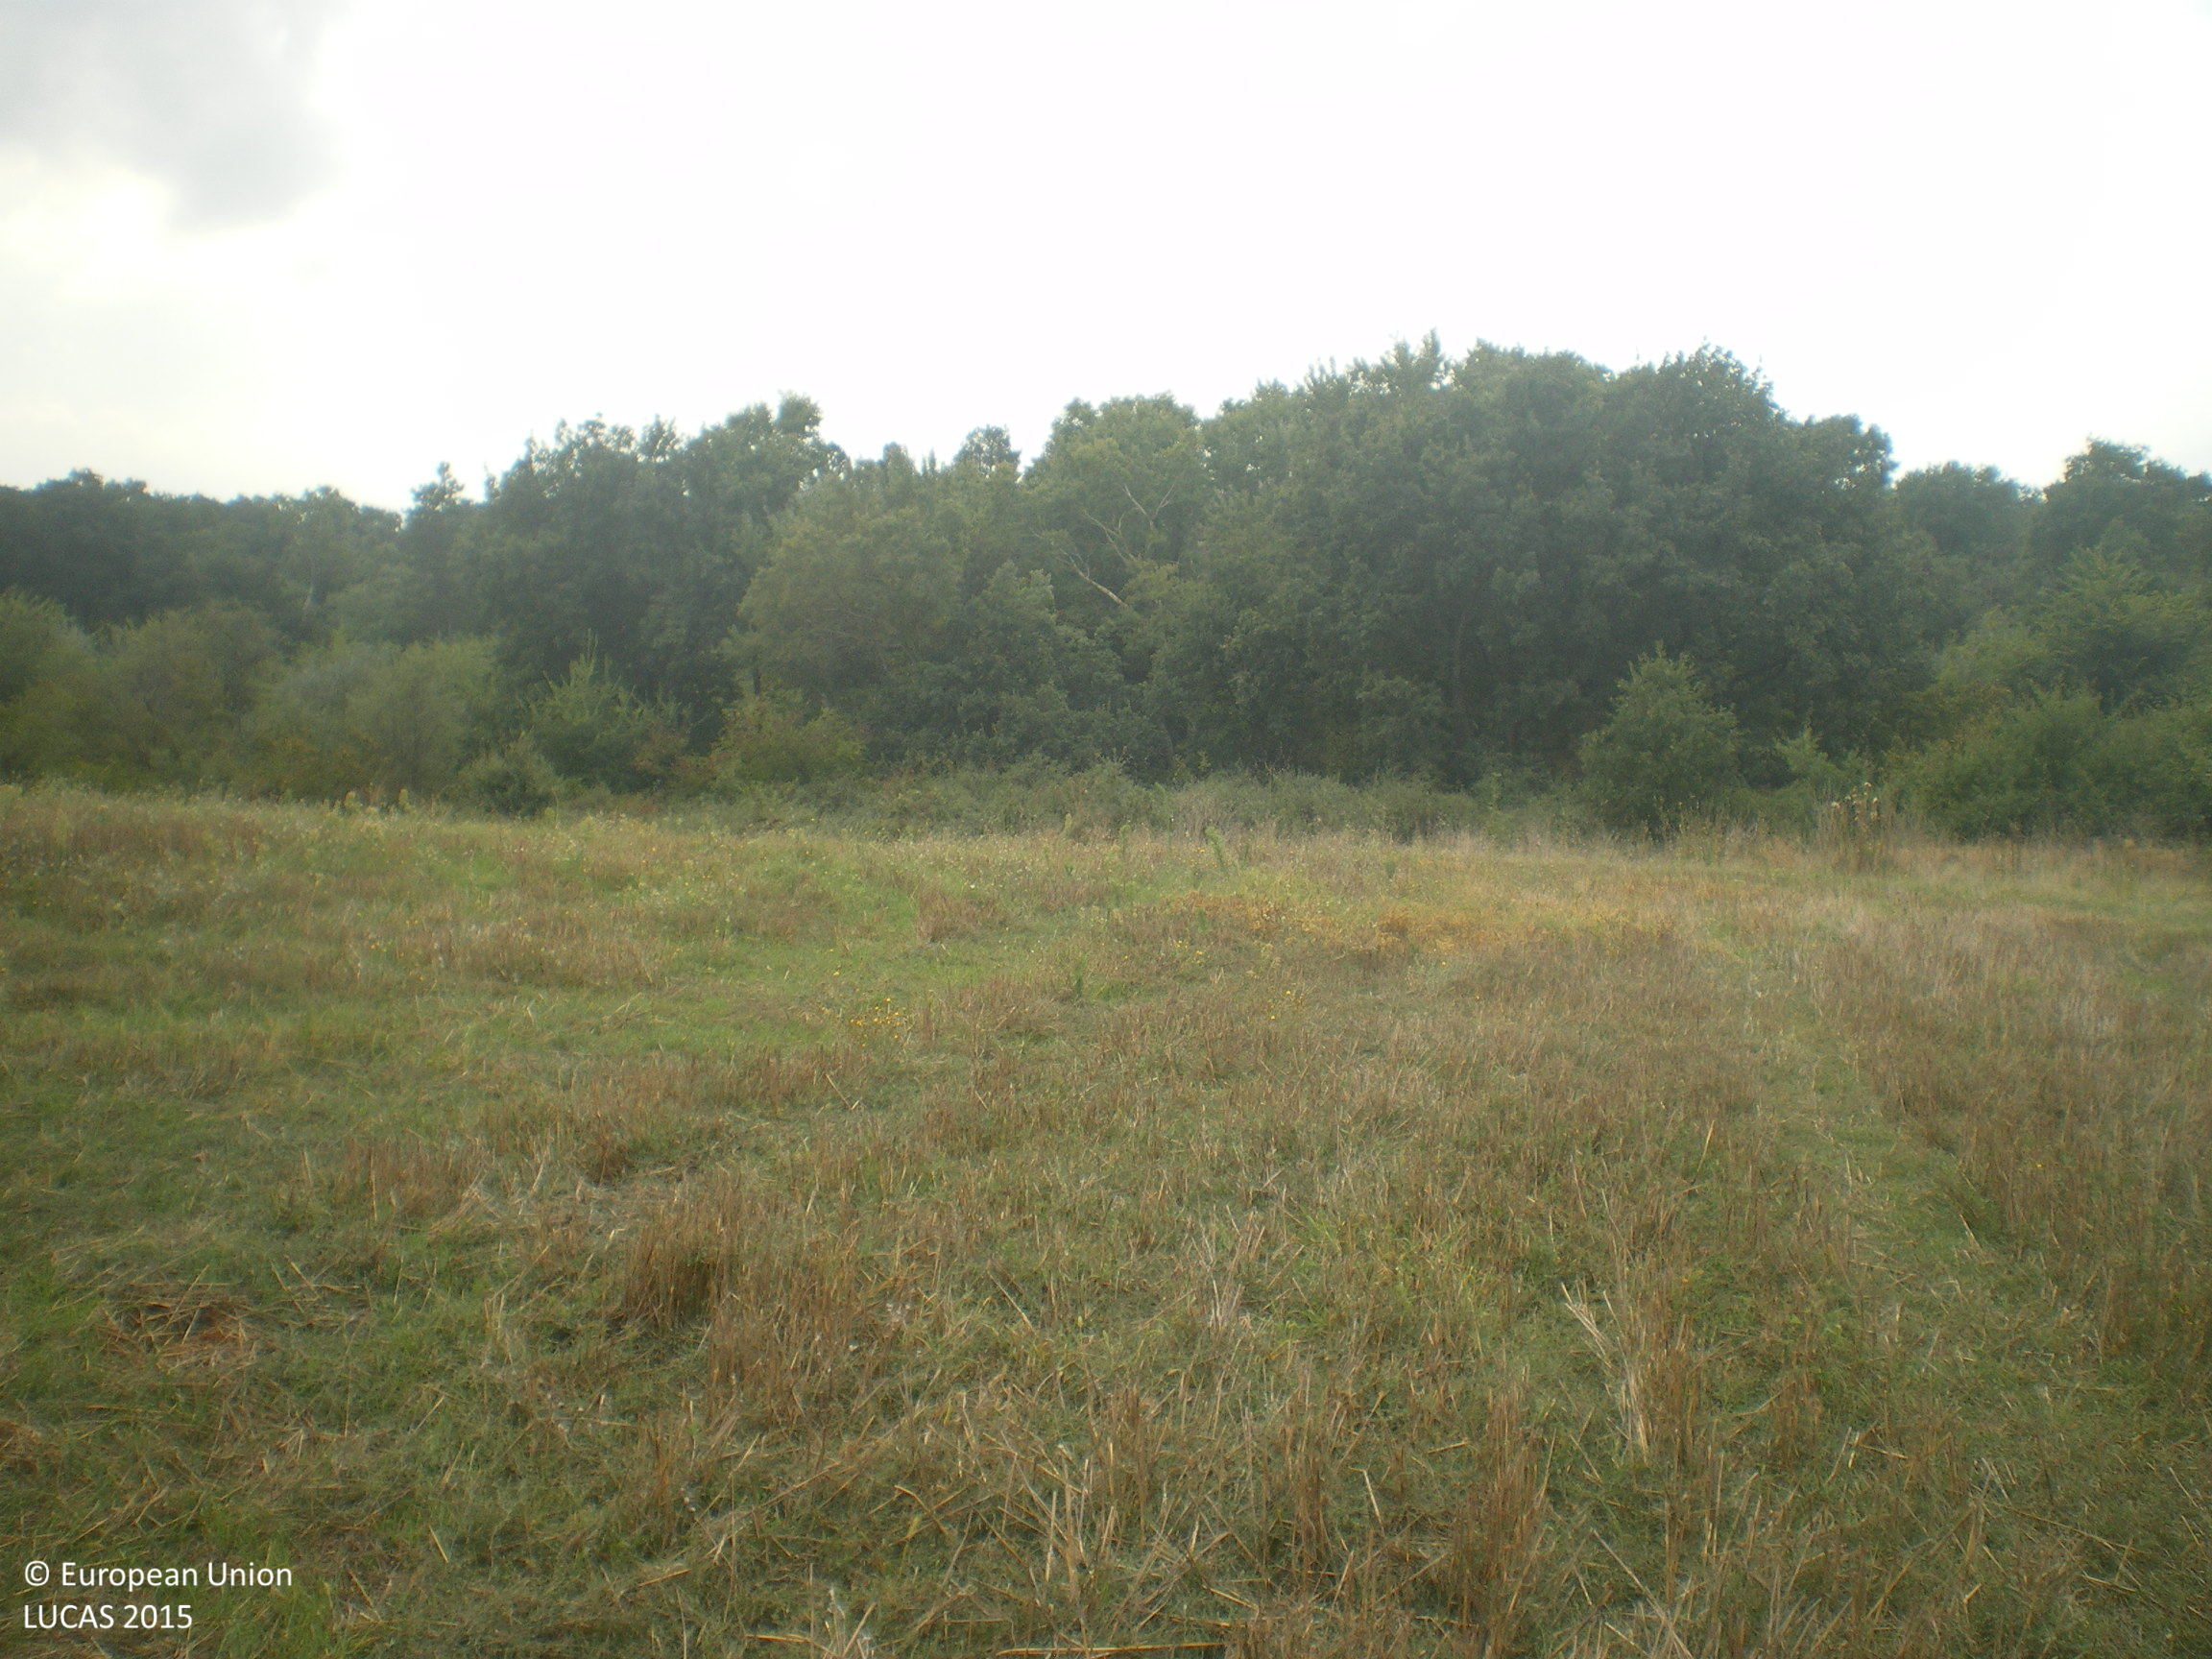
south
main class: Cropland
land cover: Common wheat
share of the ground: 10 - 25 %
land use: Agriculture (excluding fallow land and kitchen gardens)
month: September
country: BG
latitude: 42.0404
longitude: 25.9599
